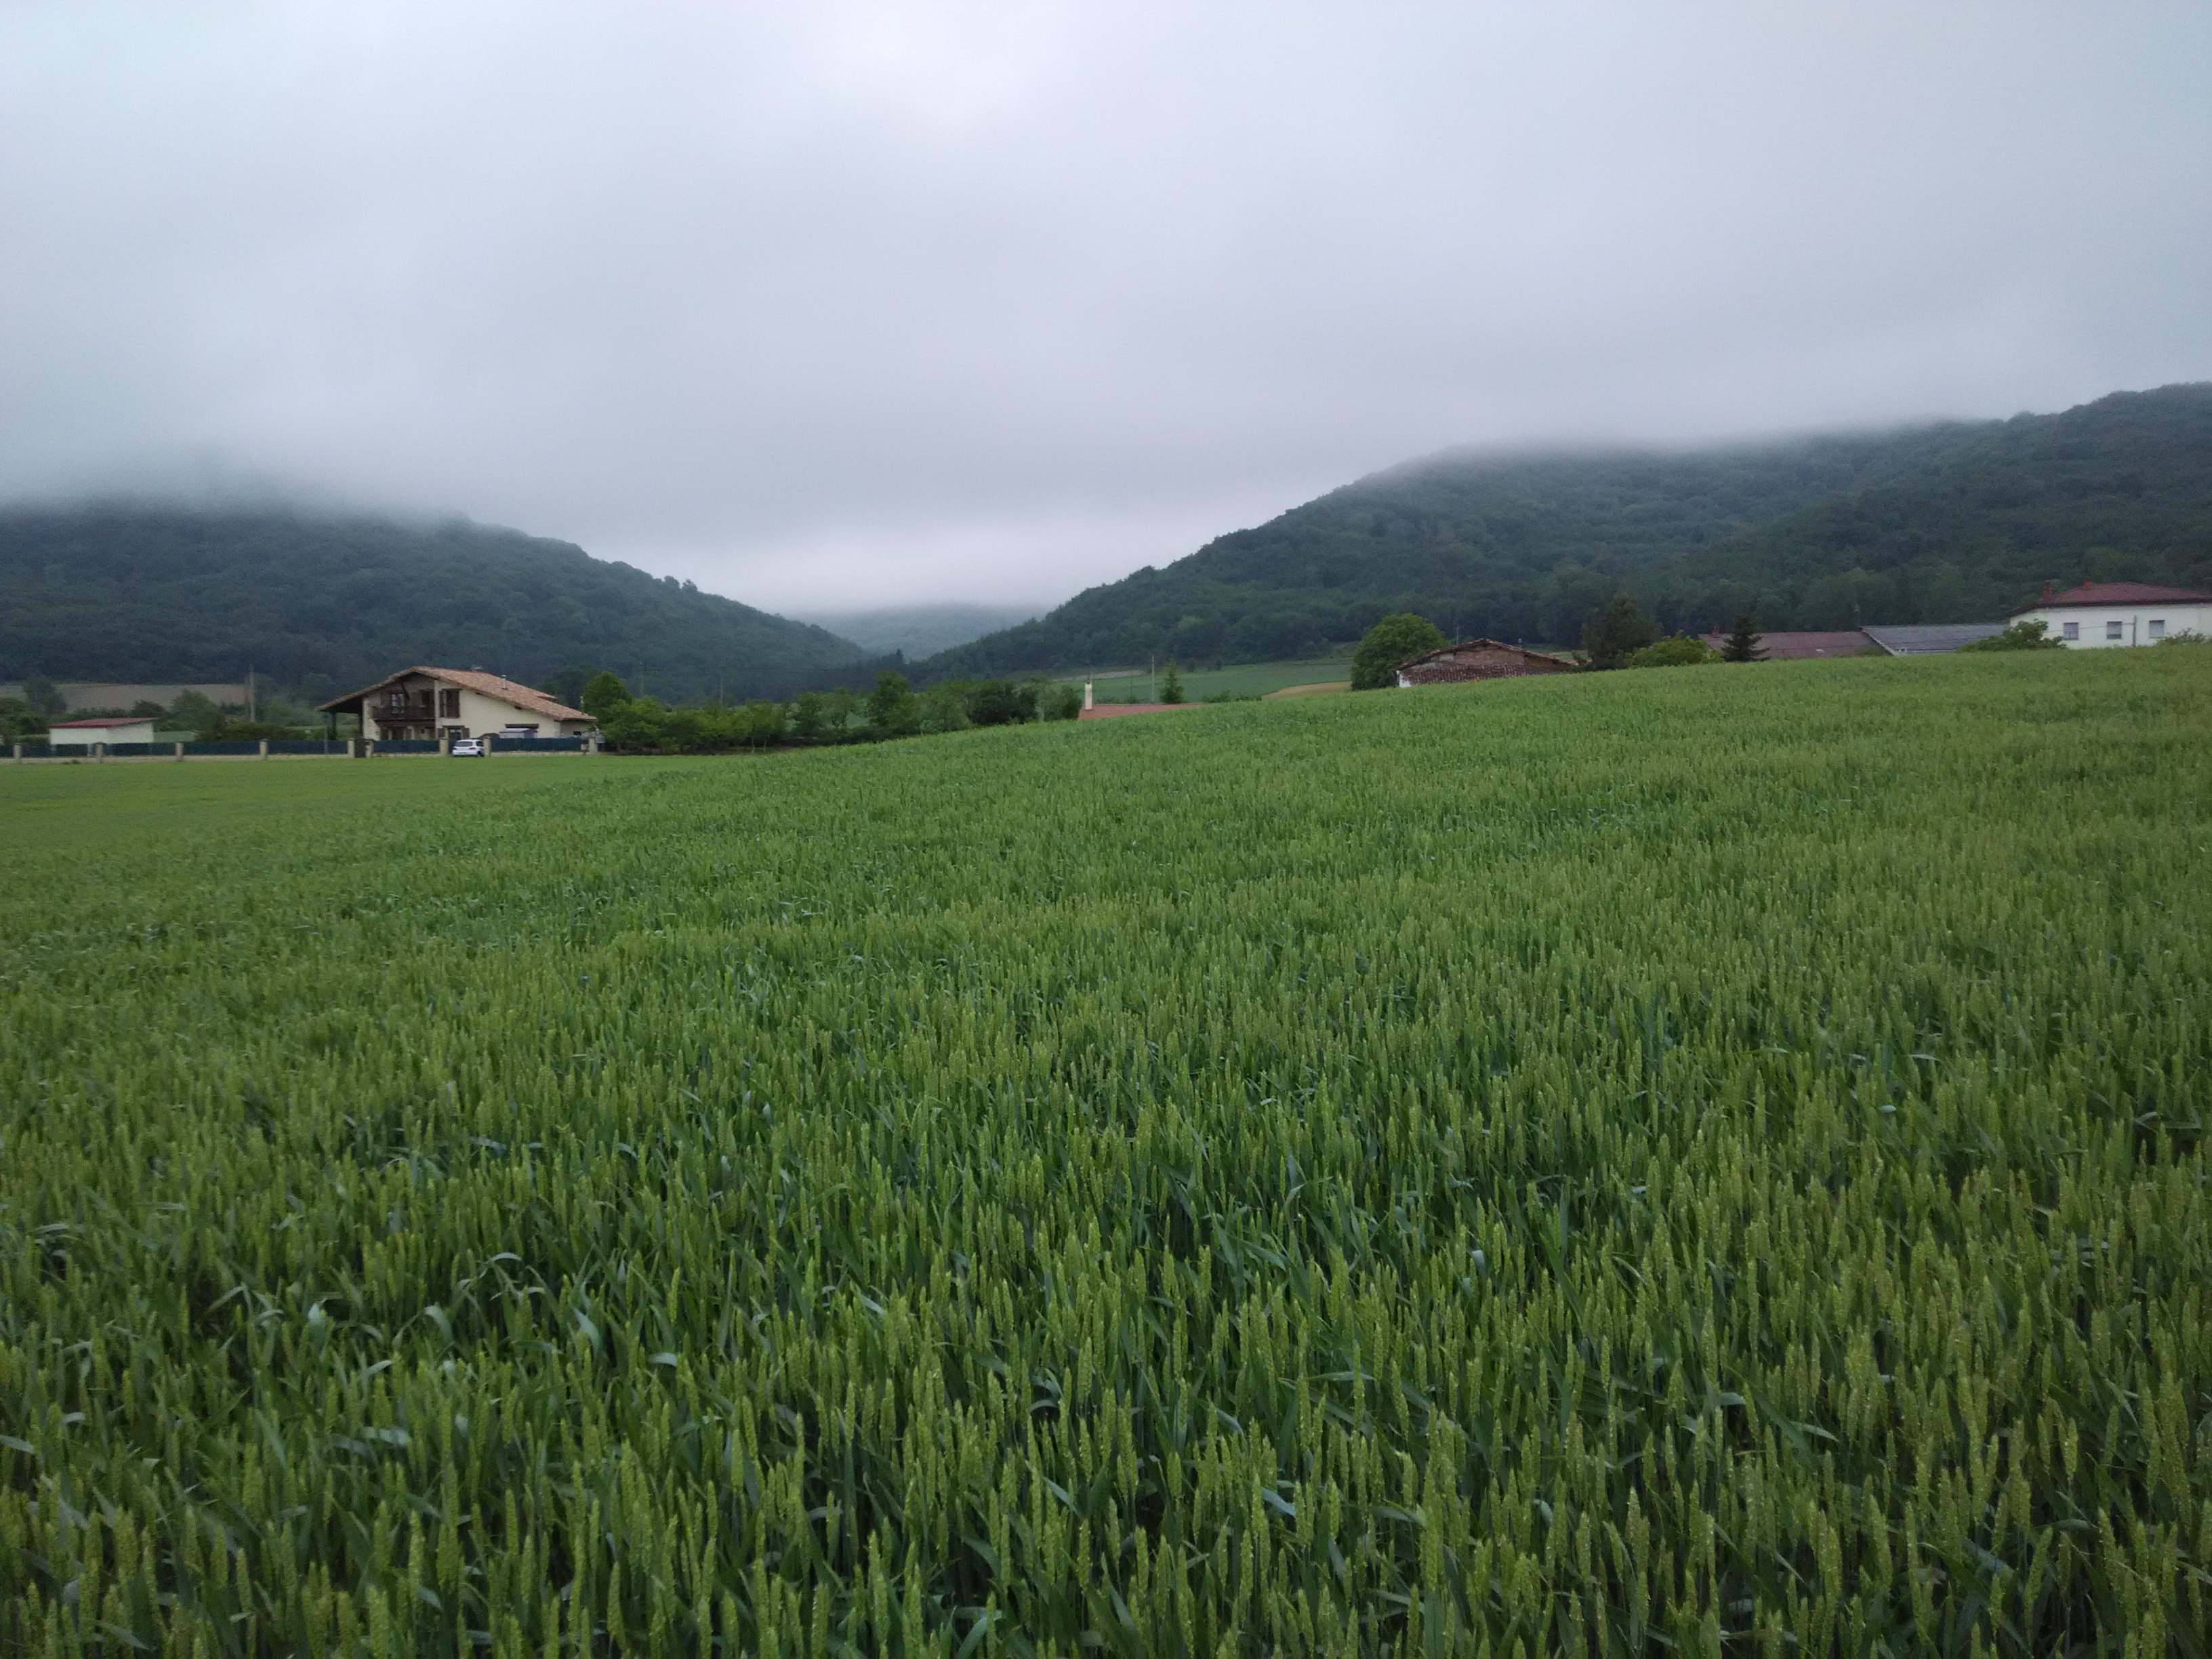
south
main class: Cropland
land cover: Common wheat
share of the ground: > 75 %
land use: Agriculture (excluding fallow land and kitchen gardens)
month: May
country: ES
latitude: 42.8119
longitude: -2.4612
